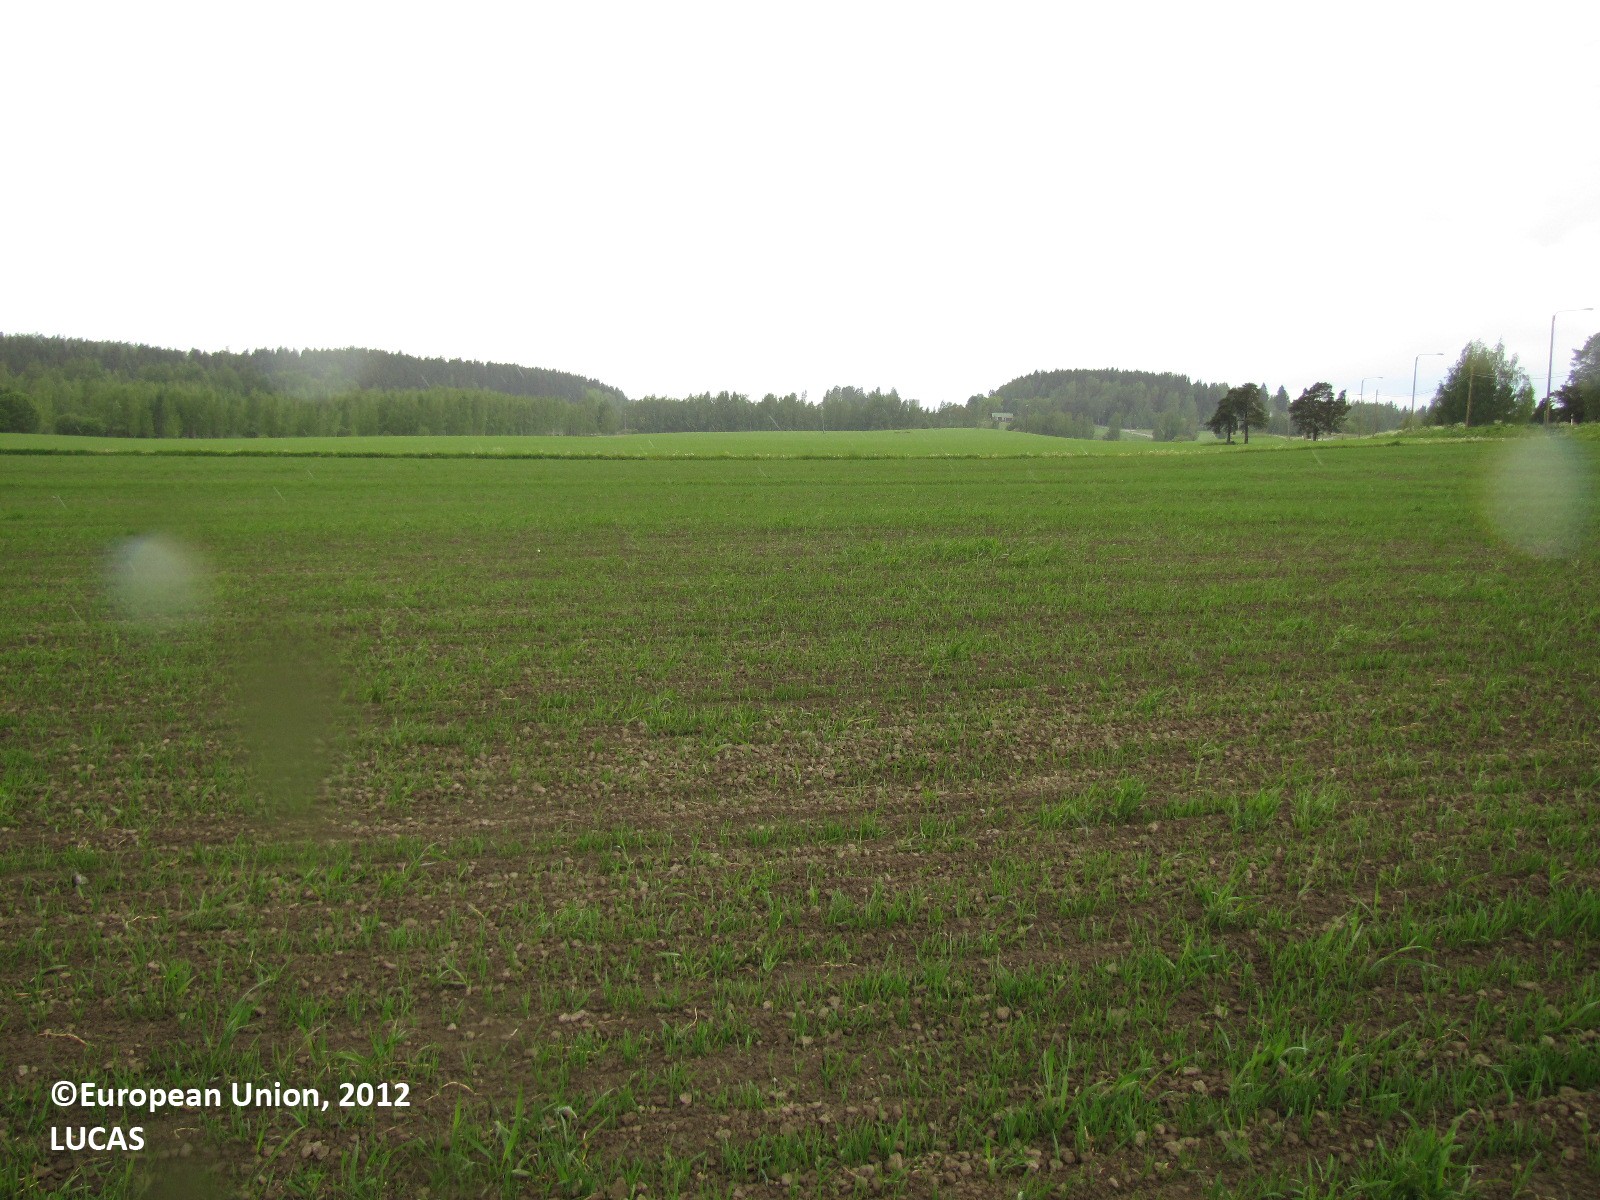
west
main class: Cropland
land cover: Common wheat
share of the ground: 25 - 50 %
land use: Agriculture (excluding fallow land and kitchen gardens)
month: June
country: FI
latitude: 61.2826
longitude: 23.5331
